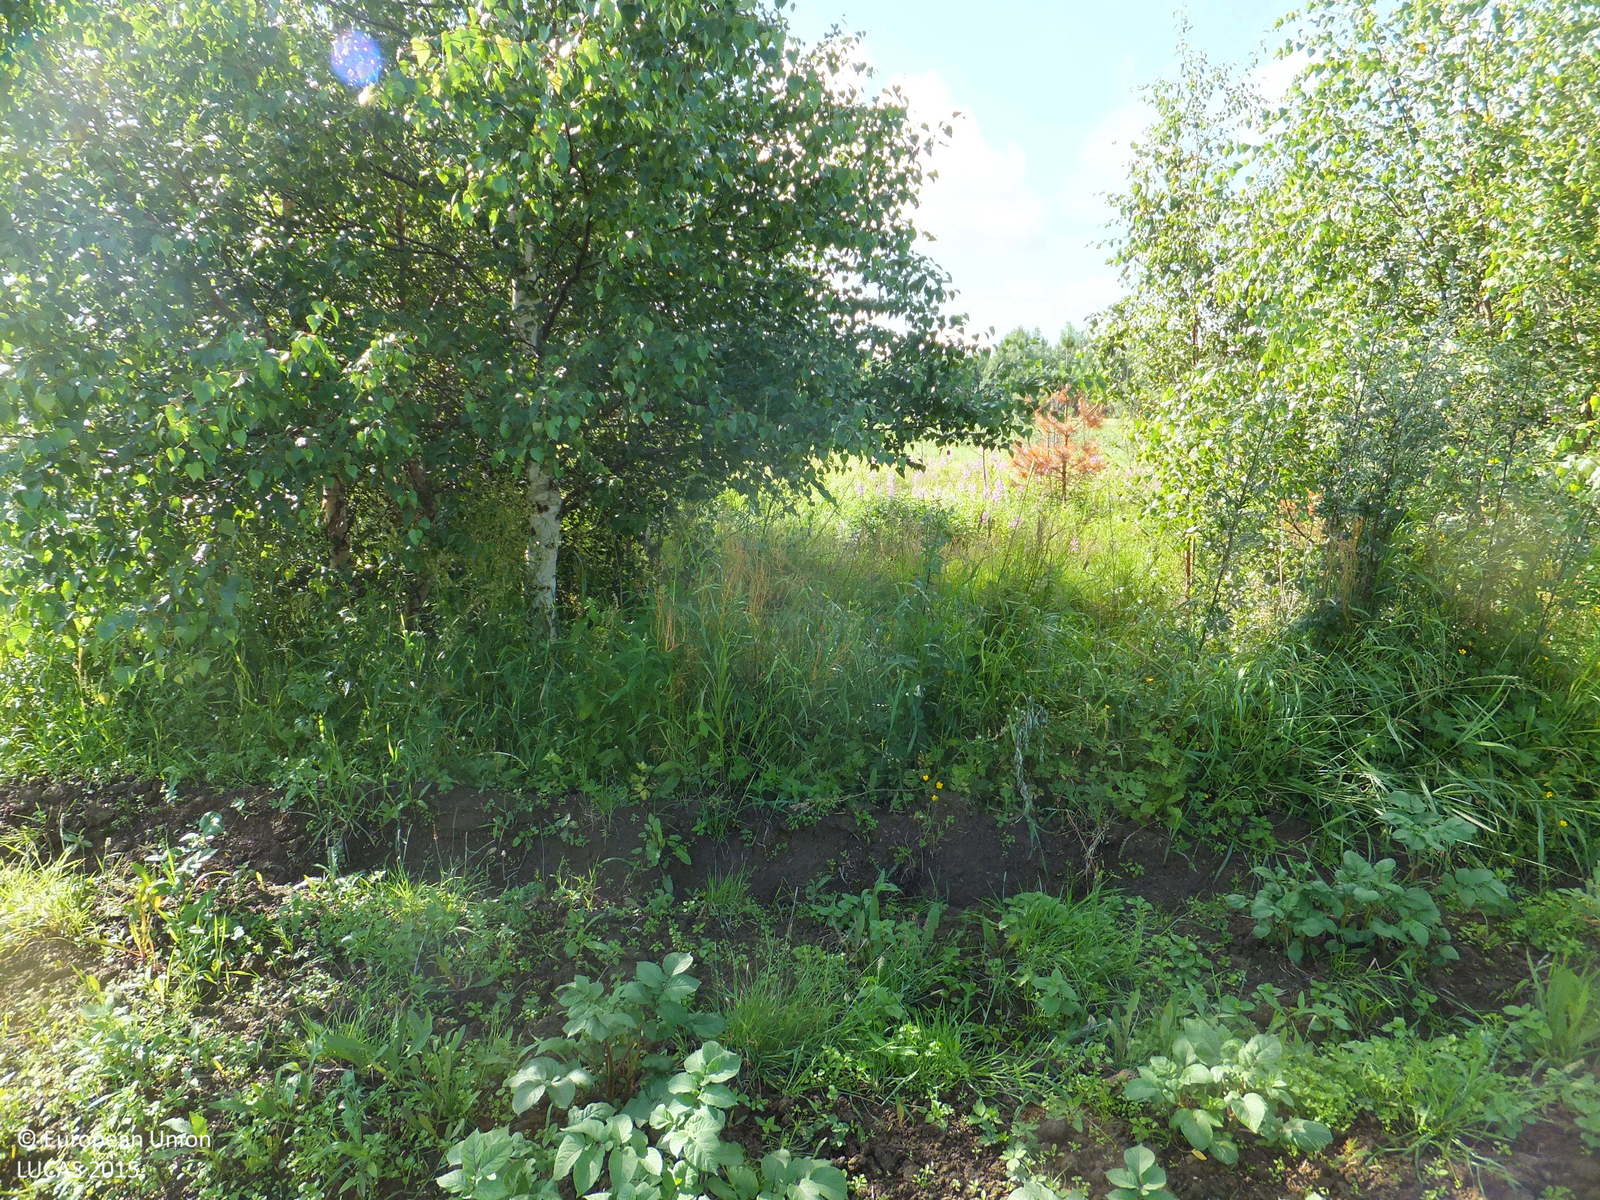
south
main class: Cropland
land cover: Potatoes
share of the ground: 25 - 50 %
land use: Agriculture (excluding fallow land and kitchen gardens)
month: July
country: FI
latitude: 63.1836
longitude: 21.6227
